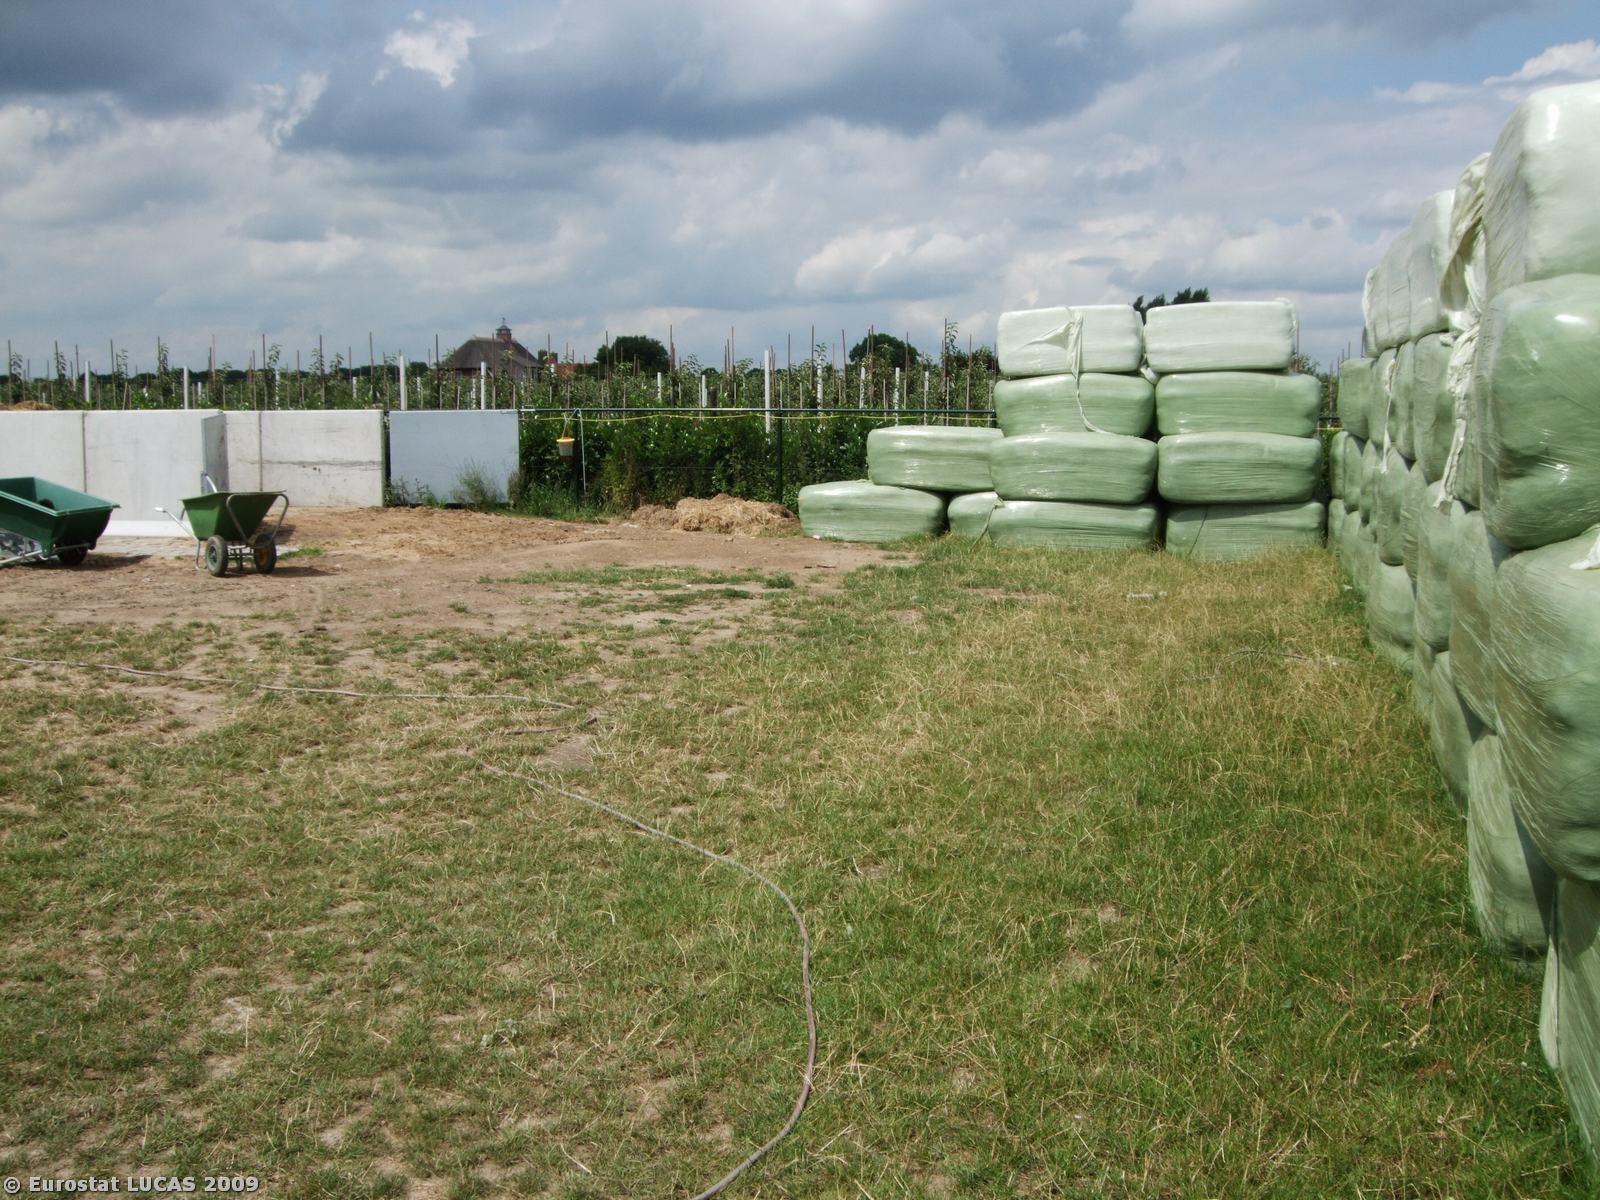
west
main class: Cropland
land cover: Apple fruit
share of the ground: 25 - 50 %
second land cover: Grassland with sparse tree/shrub cover
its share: 50 - 75 %
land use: Agriculture (excluding fallow land and kitchen gardens)
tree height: < 5 m
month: July
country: NL
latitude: 51.9110
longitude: 5.4190
